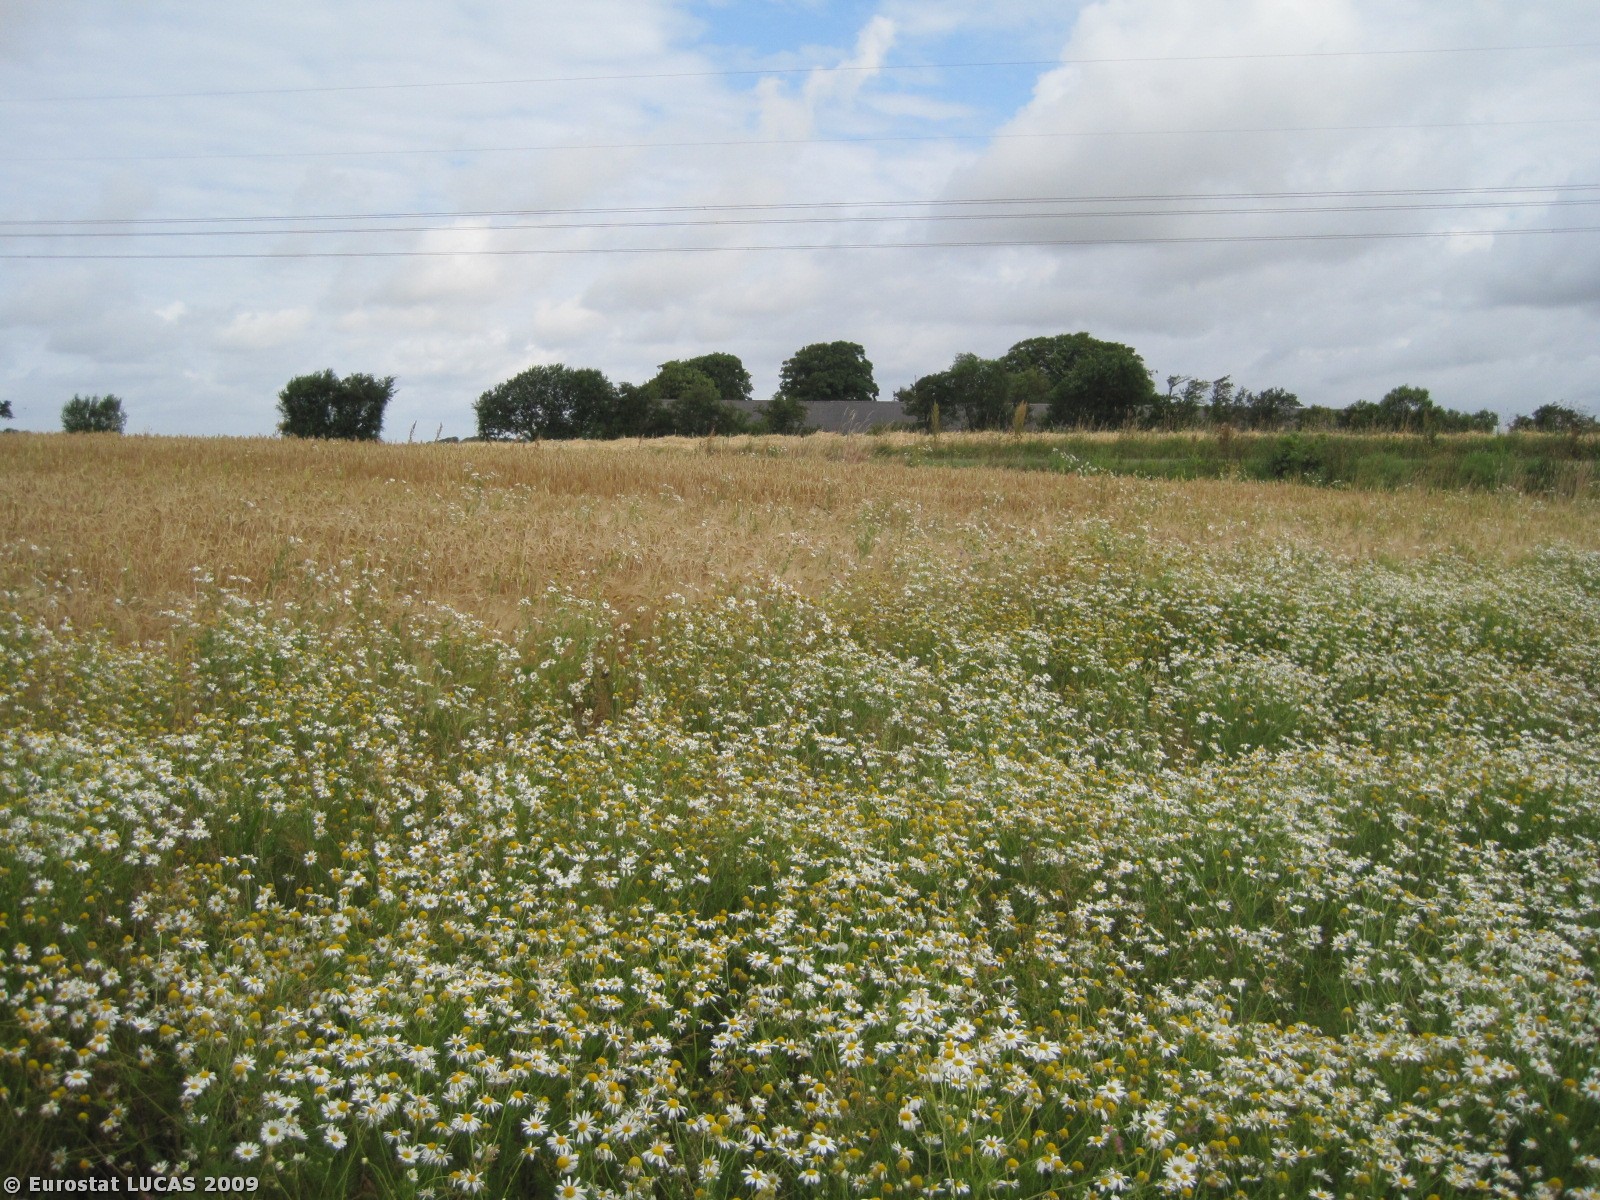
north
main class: Grassland
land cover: Grassland without tree/shrub cover
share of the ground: > 75 %
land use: Unused
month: July
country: DK
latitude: 56.3971
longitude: 8.7216
